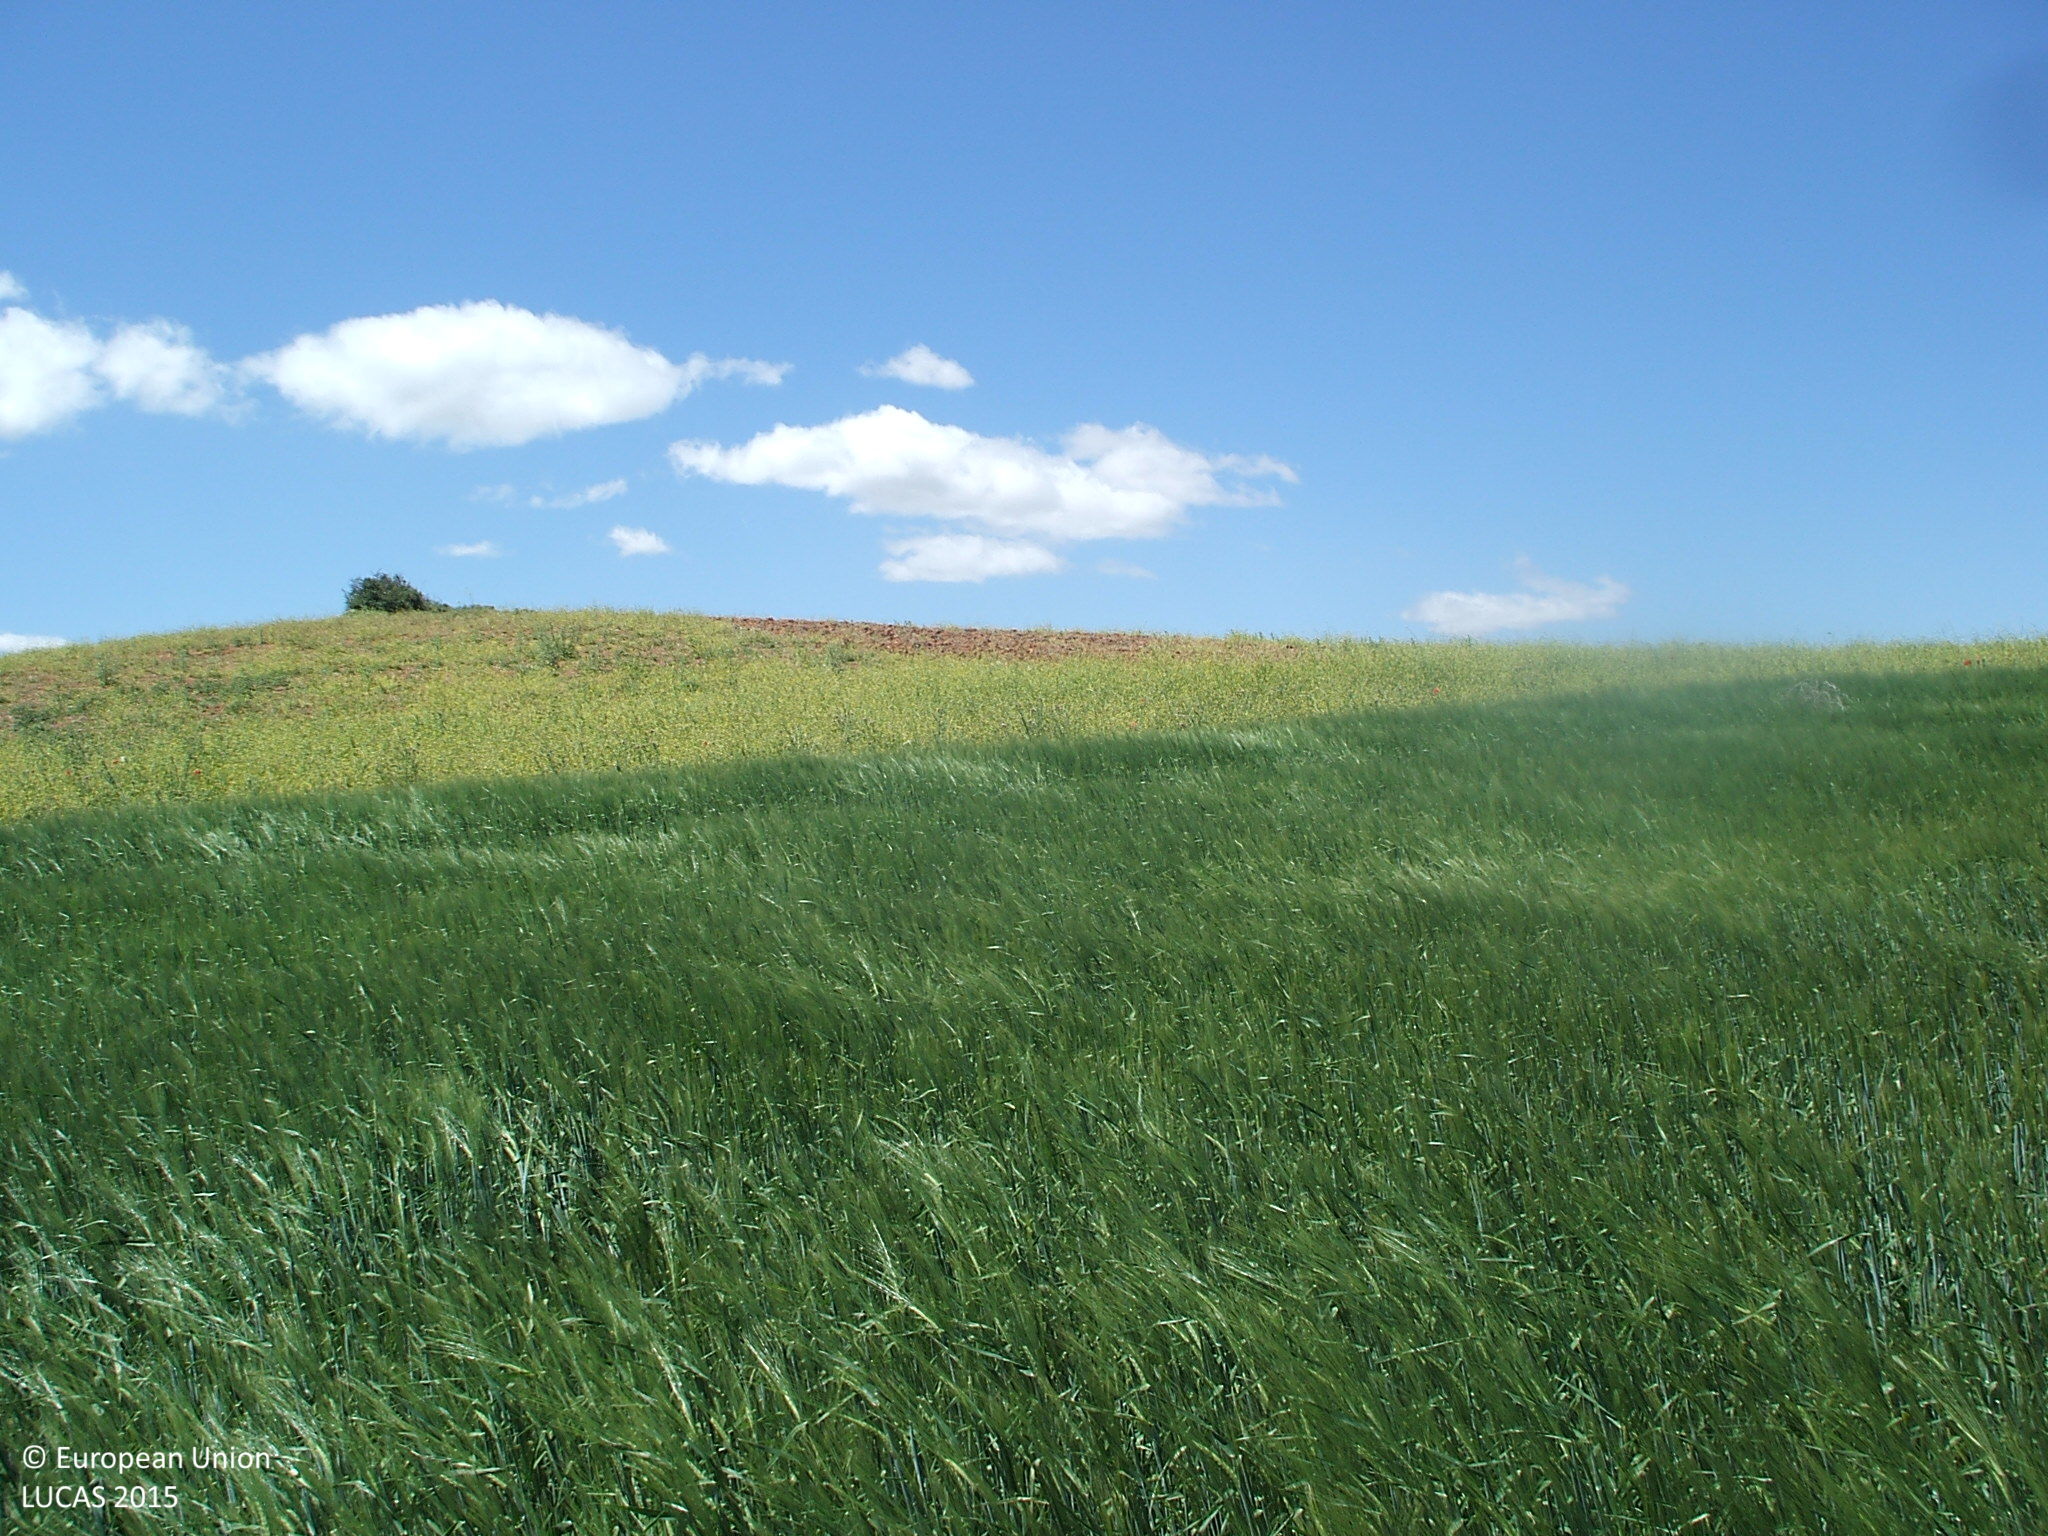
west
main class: Cropland
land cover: Barley
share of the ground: > 75 %
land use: Agriculture (excluding fallow land and kitchen gardens)
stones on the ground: 25 - 50 %
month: May
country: ES
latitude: 40.9691
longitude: -2.8794
